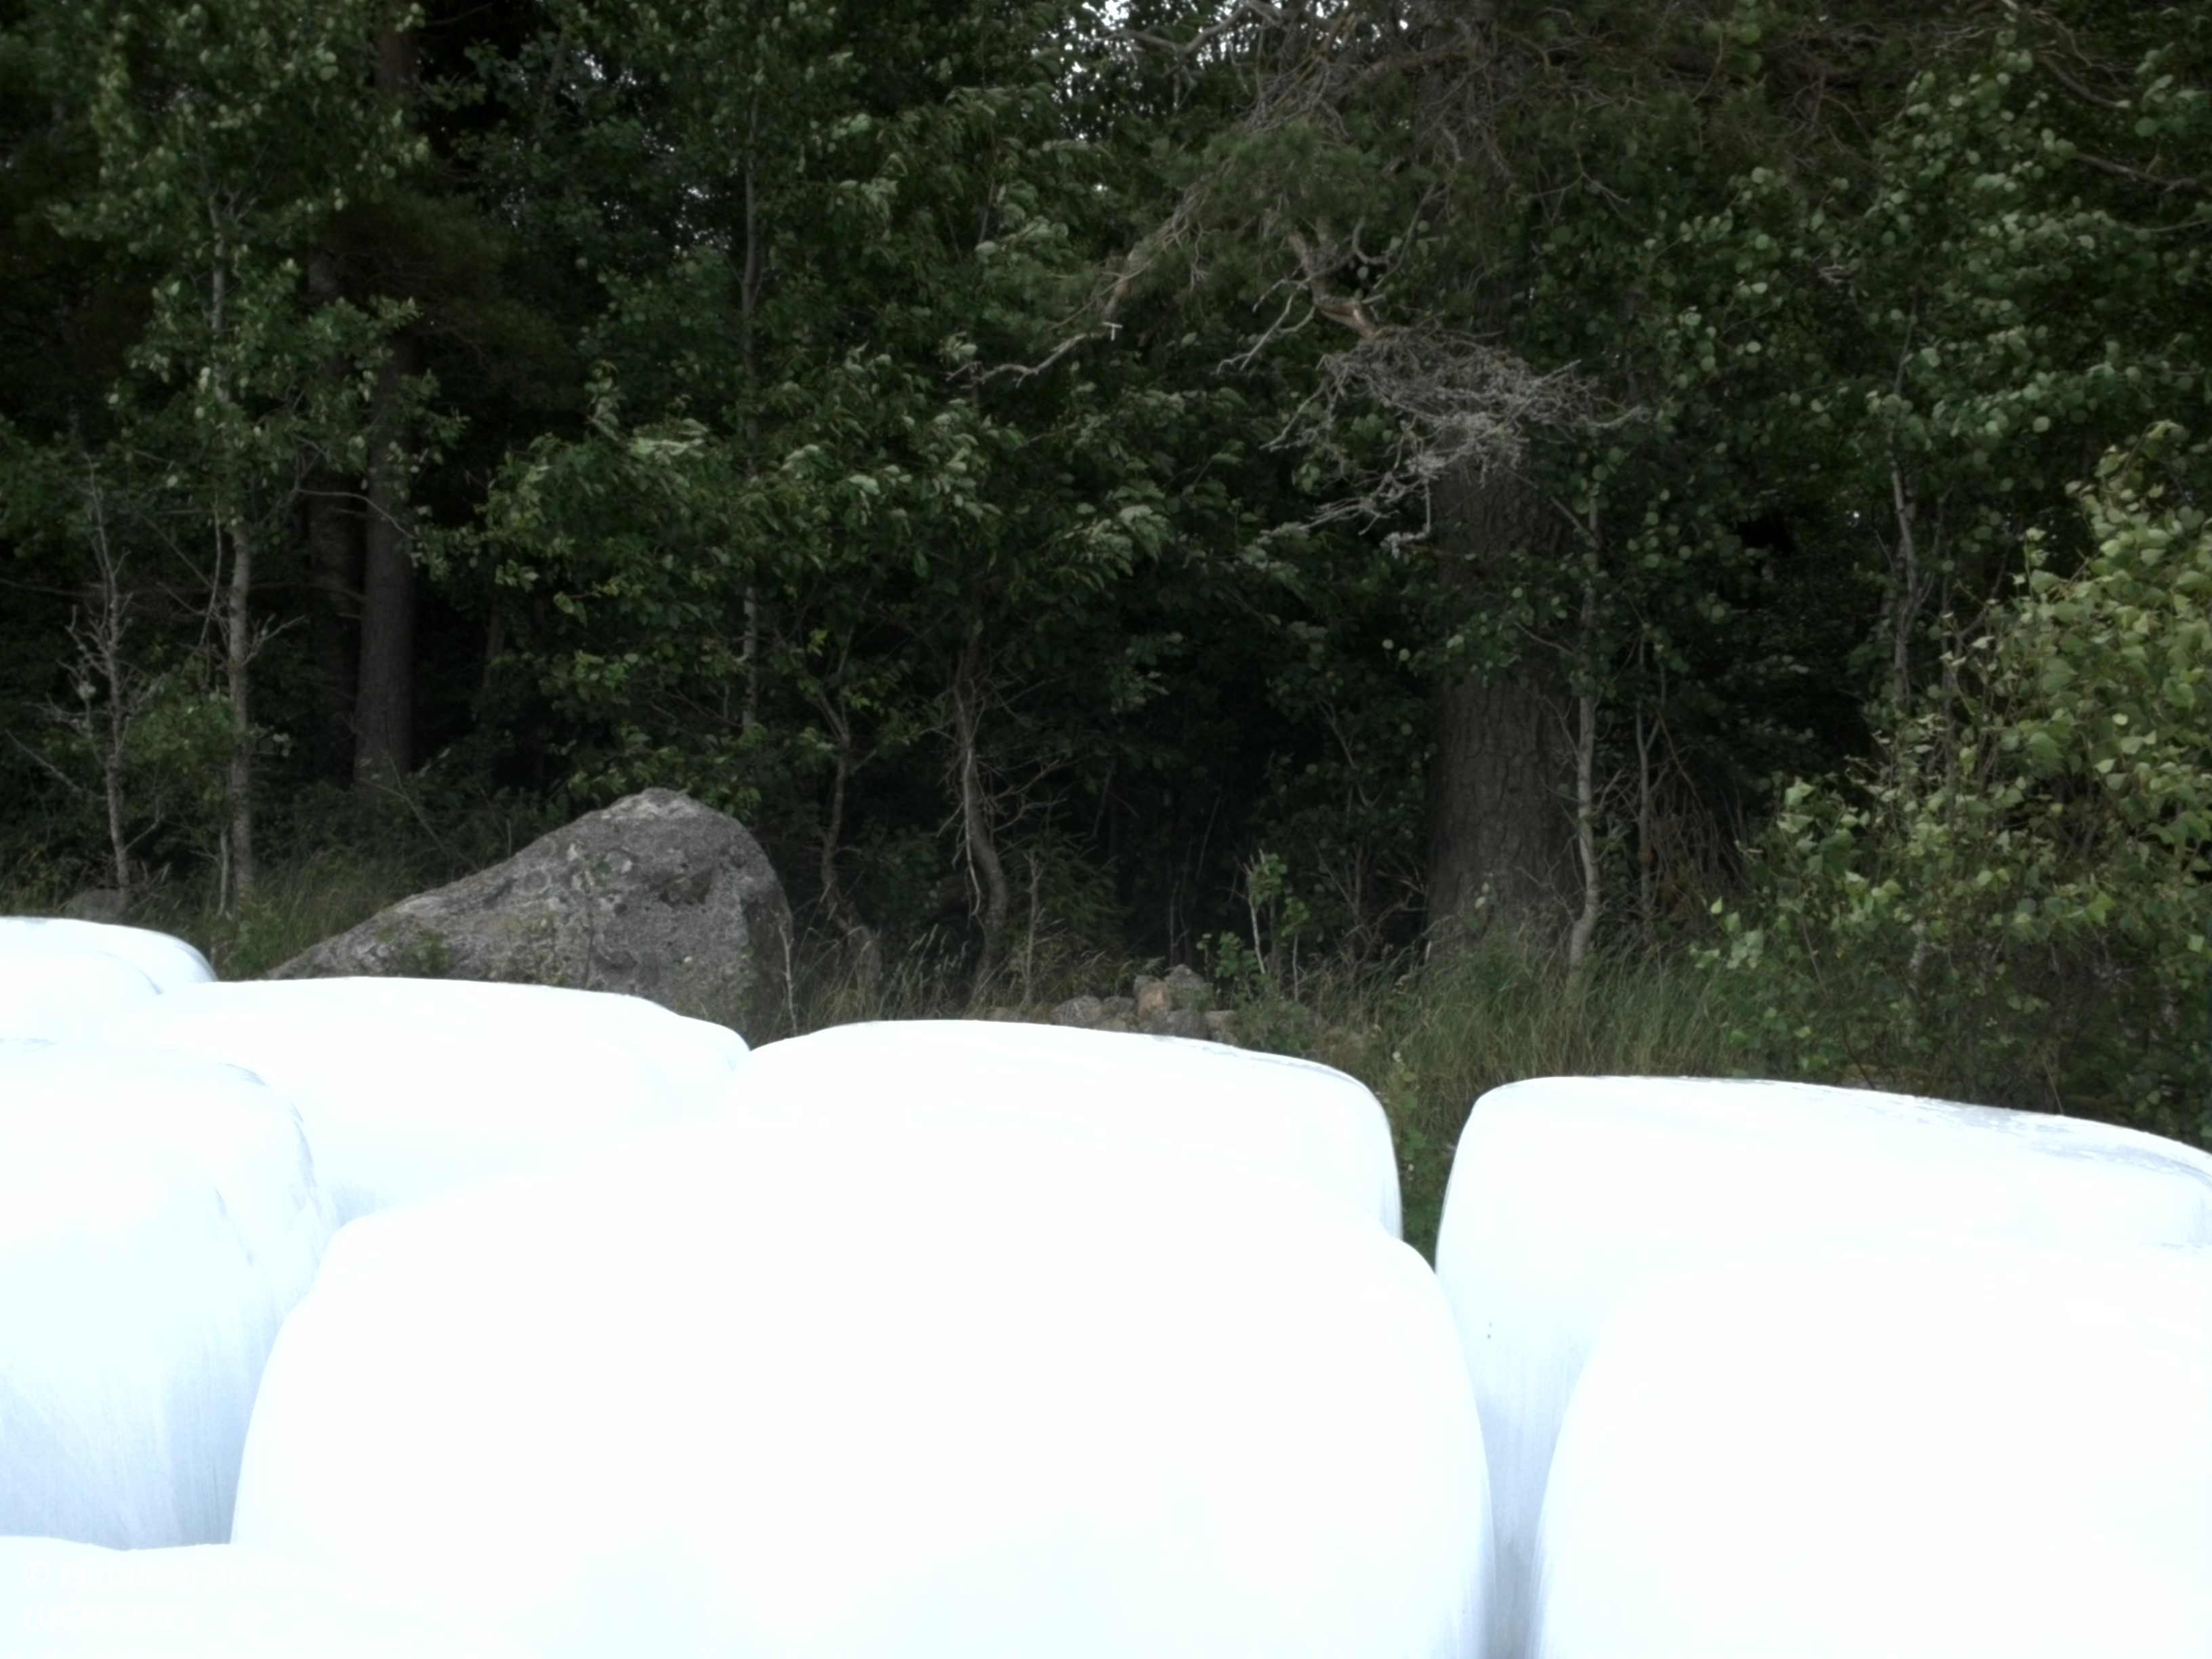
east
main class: Cropland
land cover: Temporary grasslands
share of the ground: > 75 %
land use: Agriculture (excluding fallow land and kitchen gardens)
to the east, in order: Temporary grasslands; Artificial constructions; Grass margins; Dry stone walls; Pine dominated mixed woodland; Spruce dominated mixed woodland; Rivers and streams; Spruce dominated mixed woodland
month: July
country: SE
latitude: 58.1614
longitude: 13.9543
